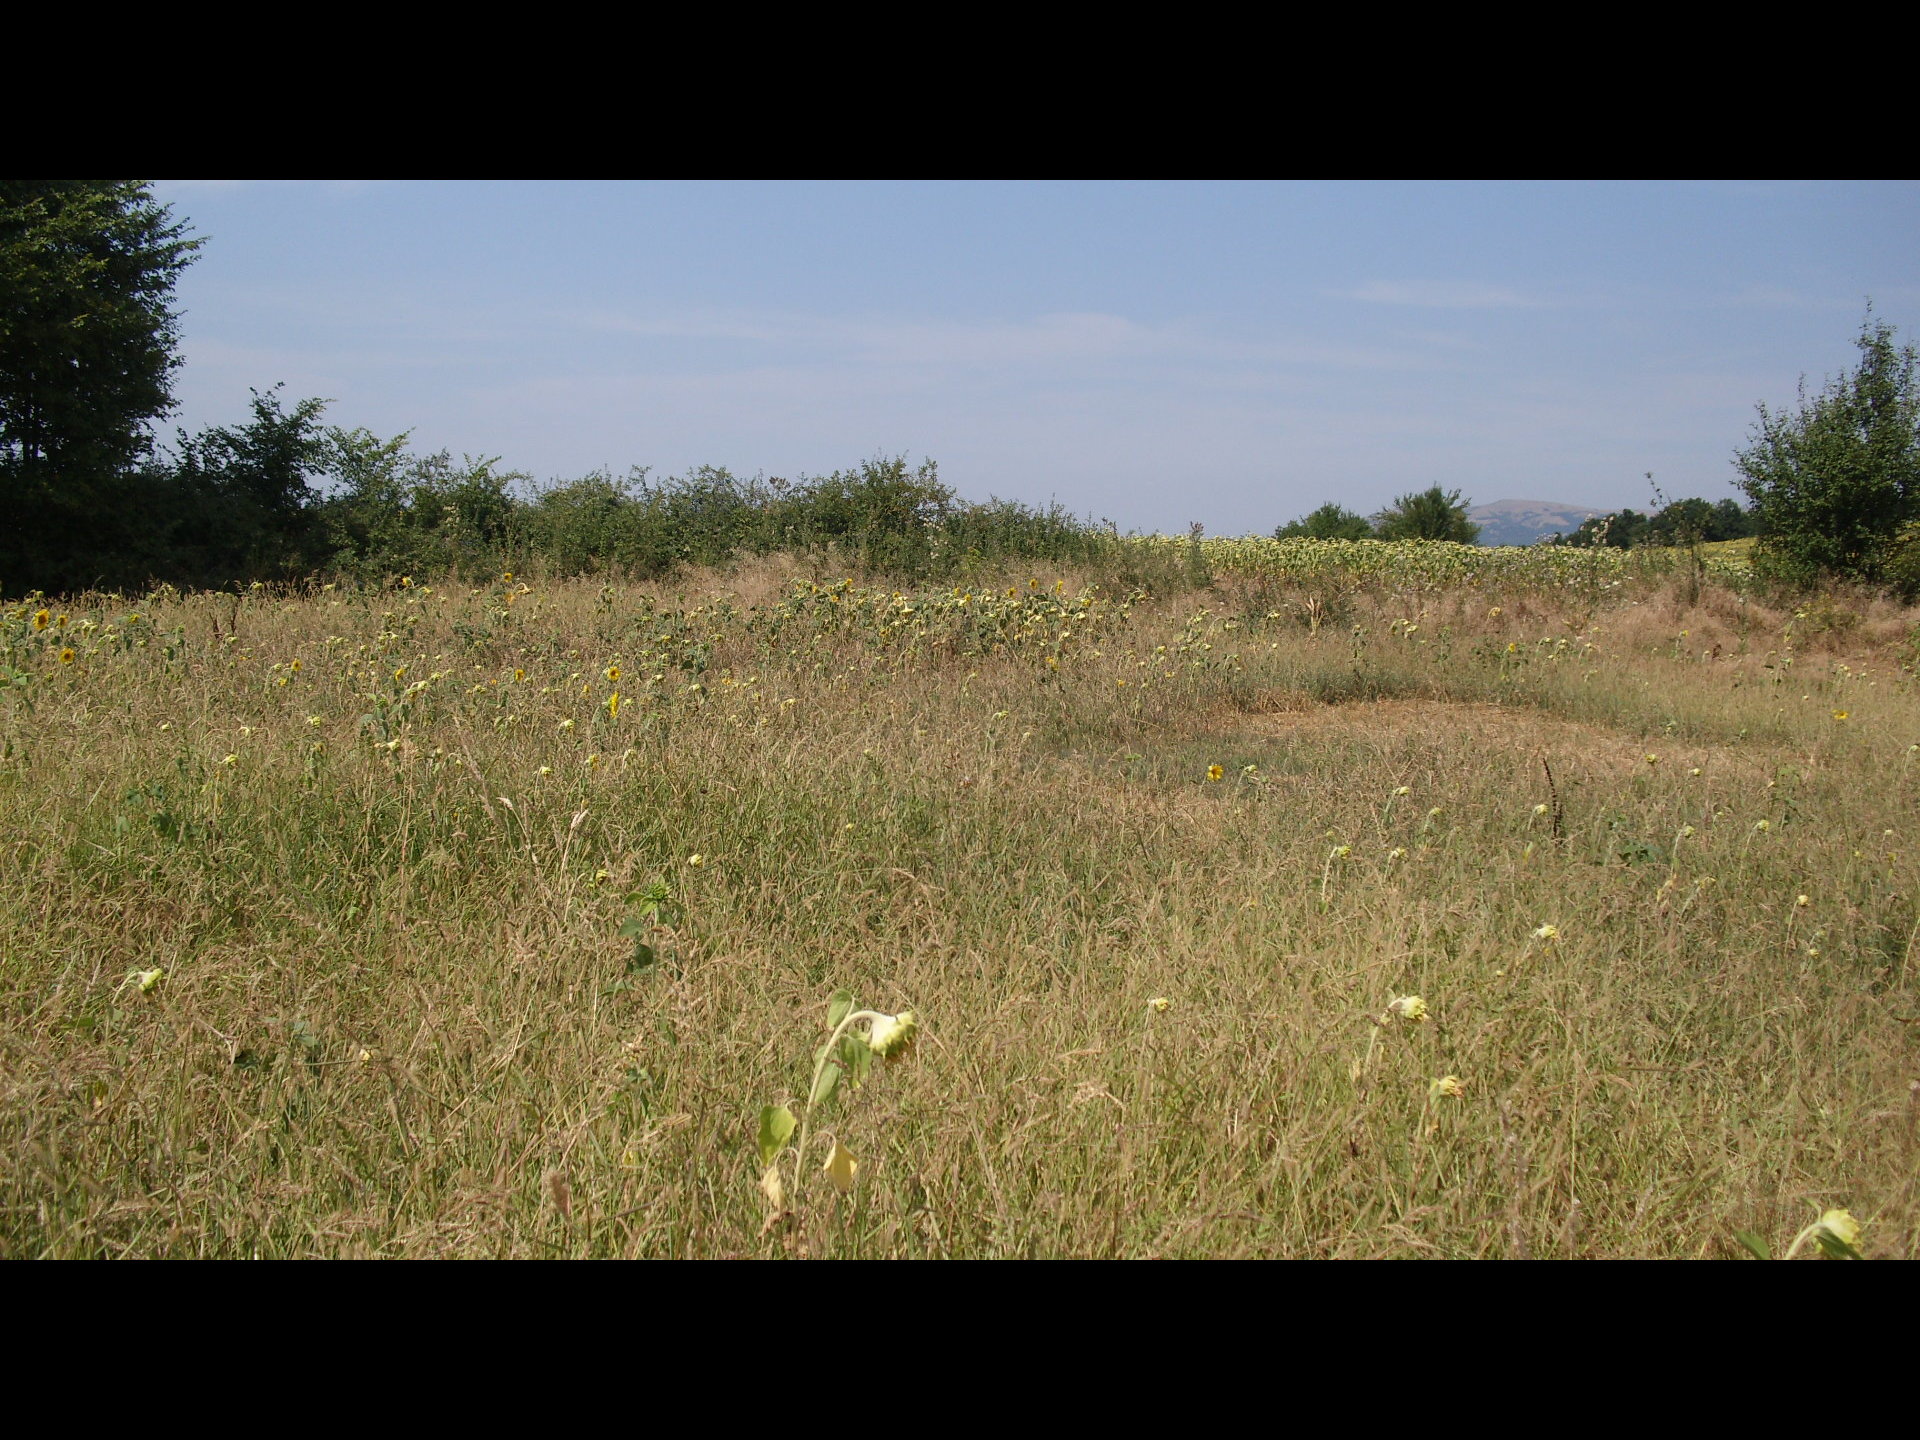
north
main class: Grassland
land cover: Spontaneously vegetated surfaces
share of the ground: > 75 %
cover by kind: herbaceous plants 100 %
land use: Agriculture (excluding fallow land and kitchen gardens)
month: August
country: BG
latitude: 43.3116
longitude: 23.2686
